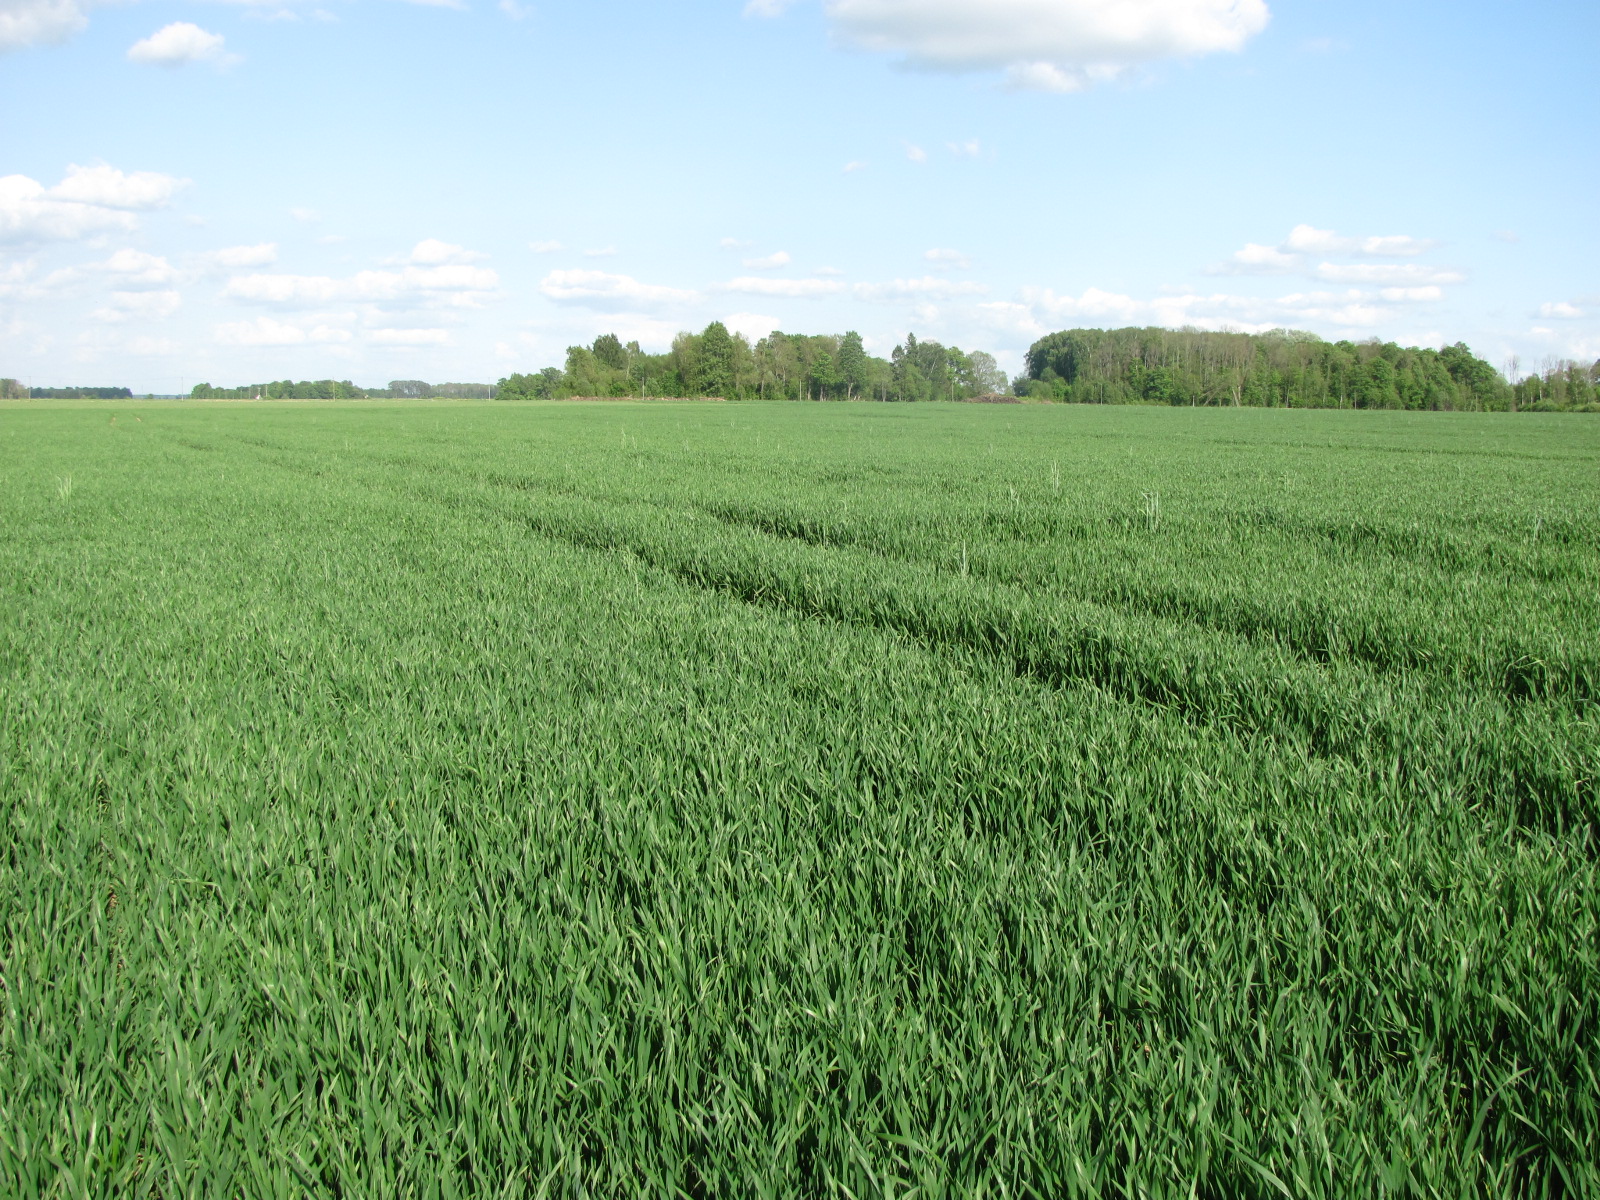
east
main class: Cropland
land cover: Common wheat
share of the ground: > 75 %
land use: Agriculture (excluding fallow land and kitchen gardens)
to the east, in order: Common wheat; Dry pulses
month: May
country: LV
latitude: 56.5423
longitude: 23.8903
